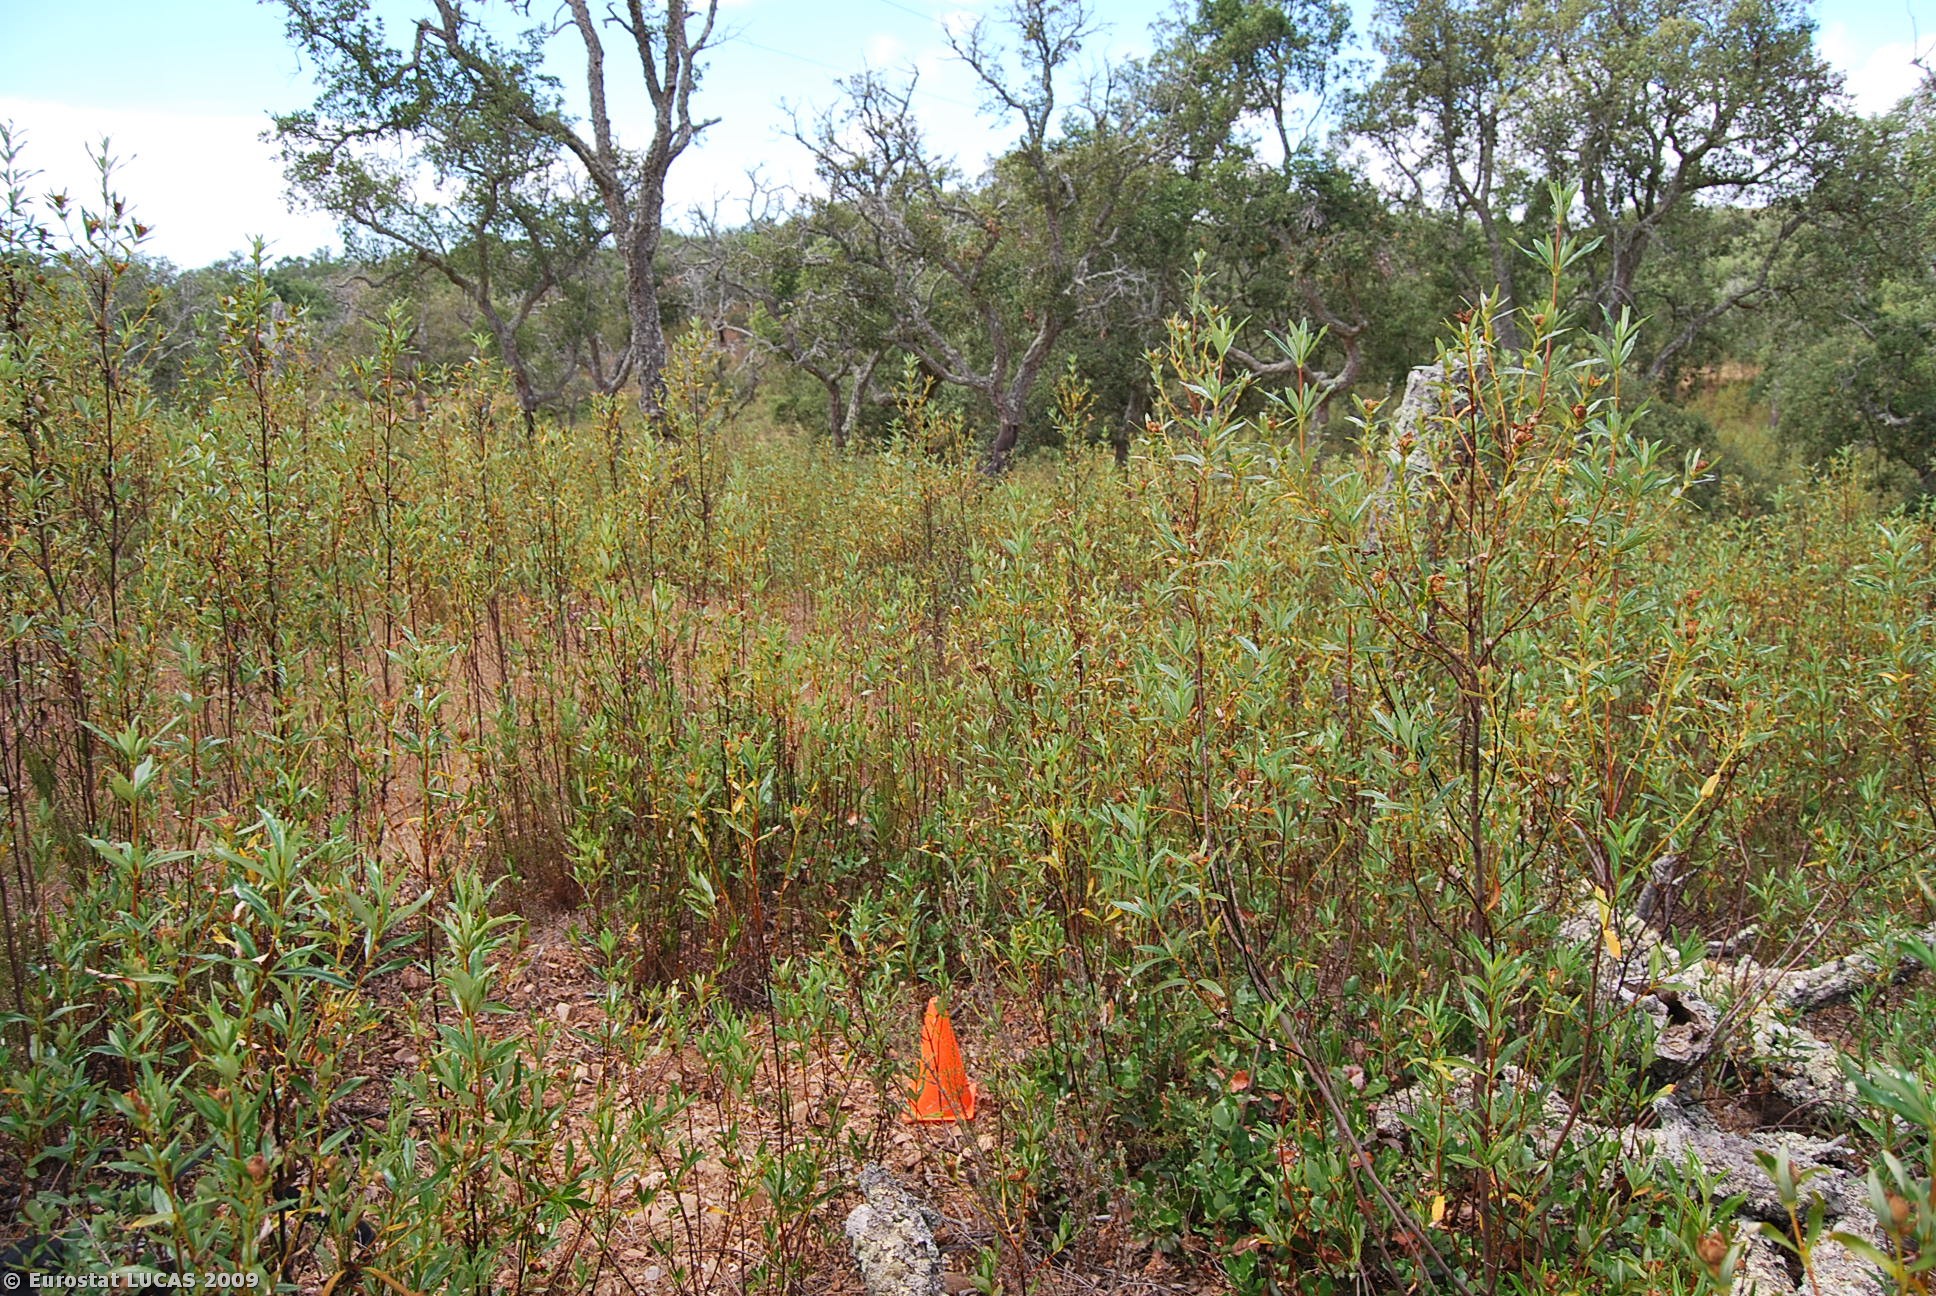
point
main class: Shrubland
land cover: Shrubland with sparse tree cover
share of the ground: > 75 %
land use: Unused
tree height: > 5 m
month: June
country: PT
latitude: 37.8985
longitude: -8.6848
